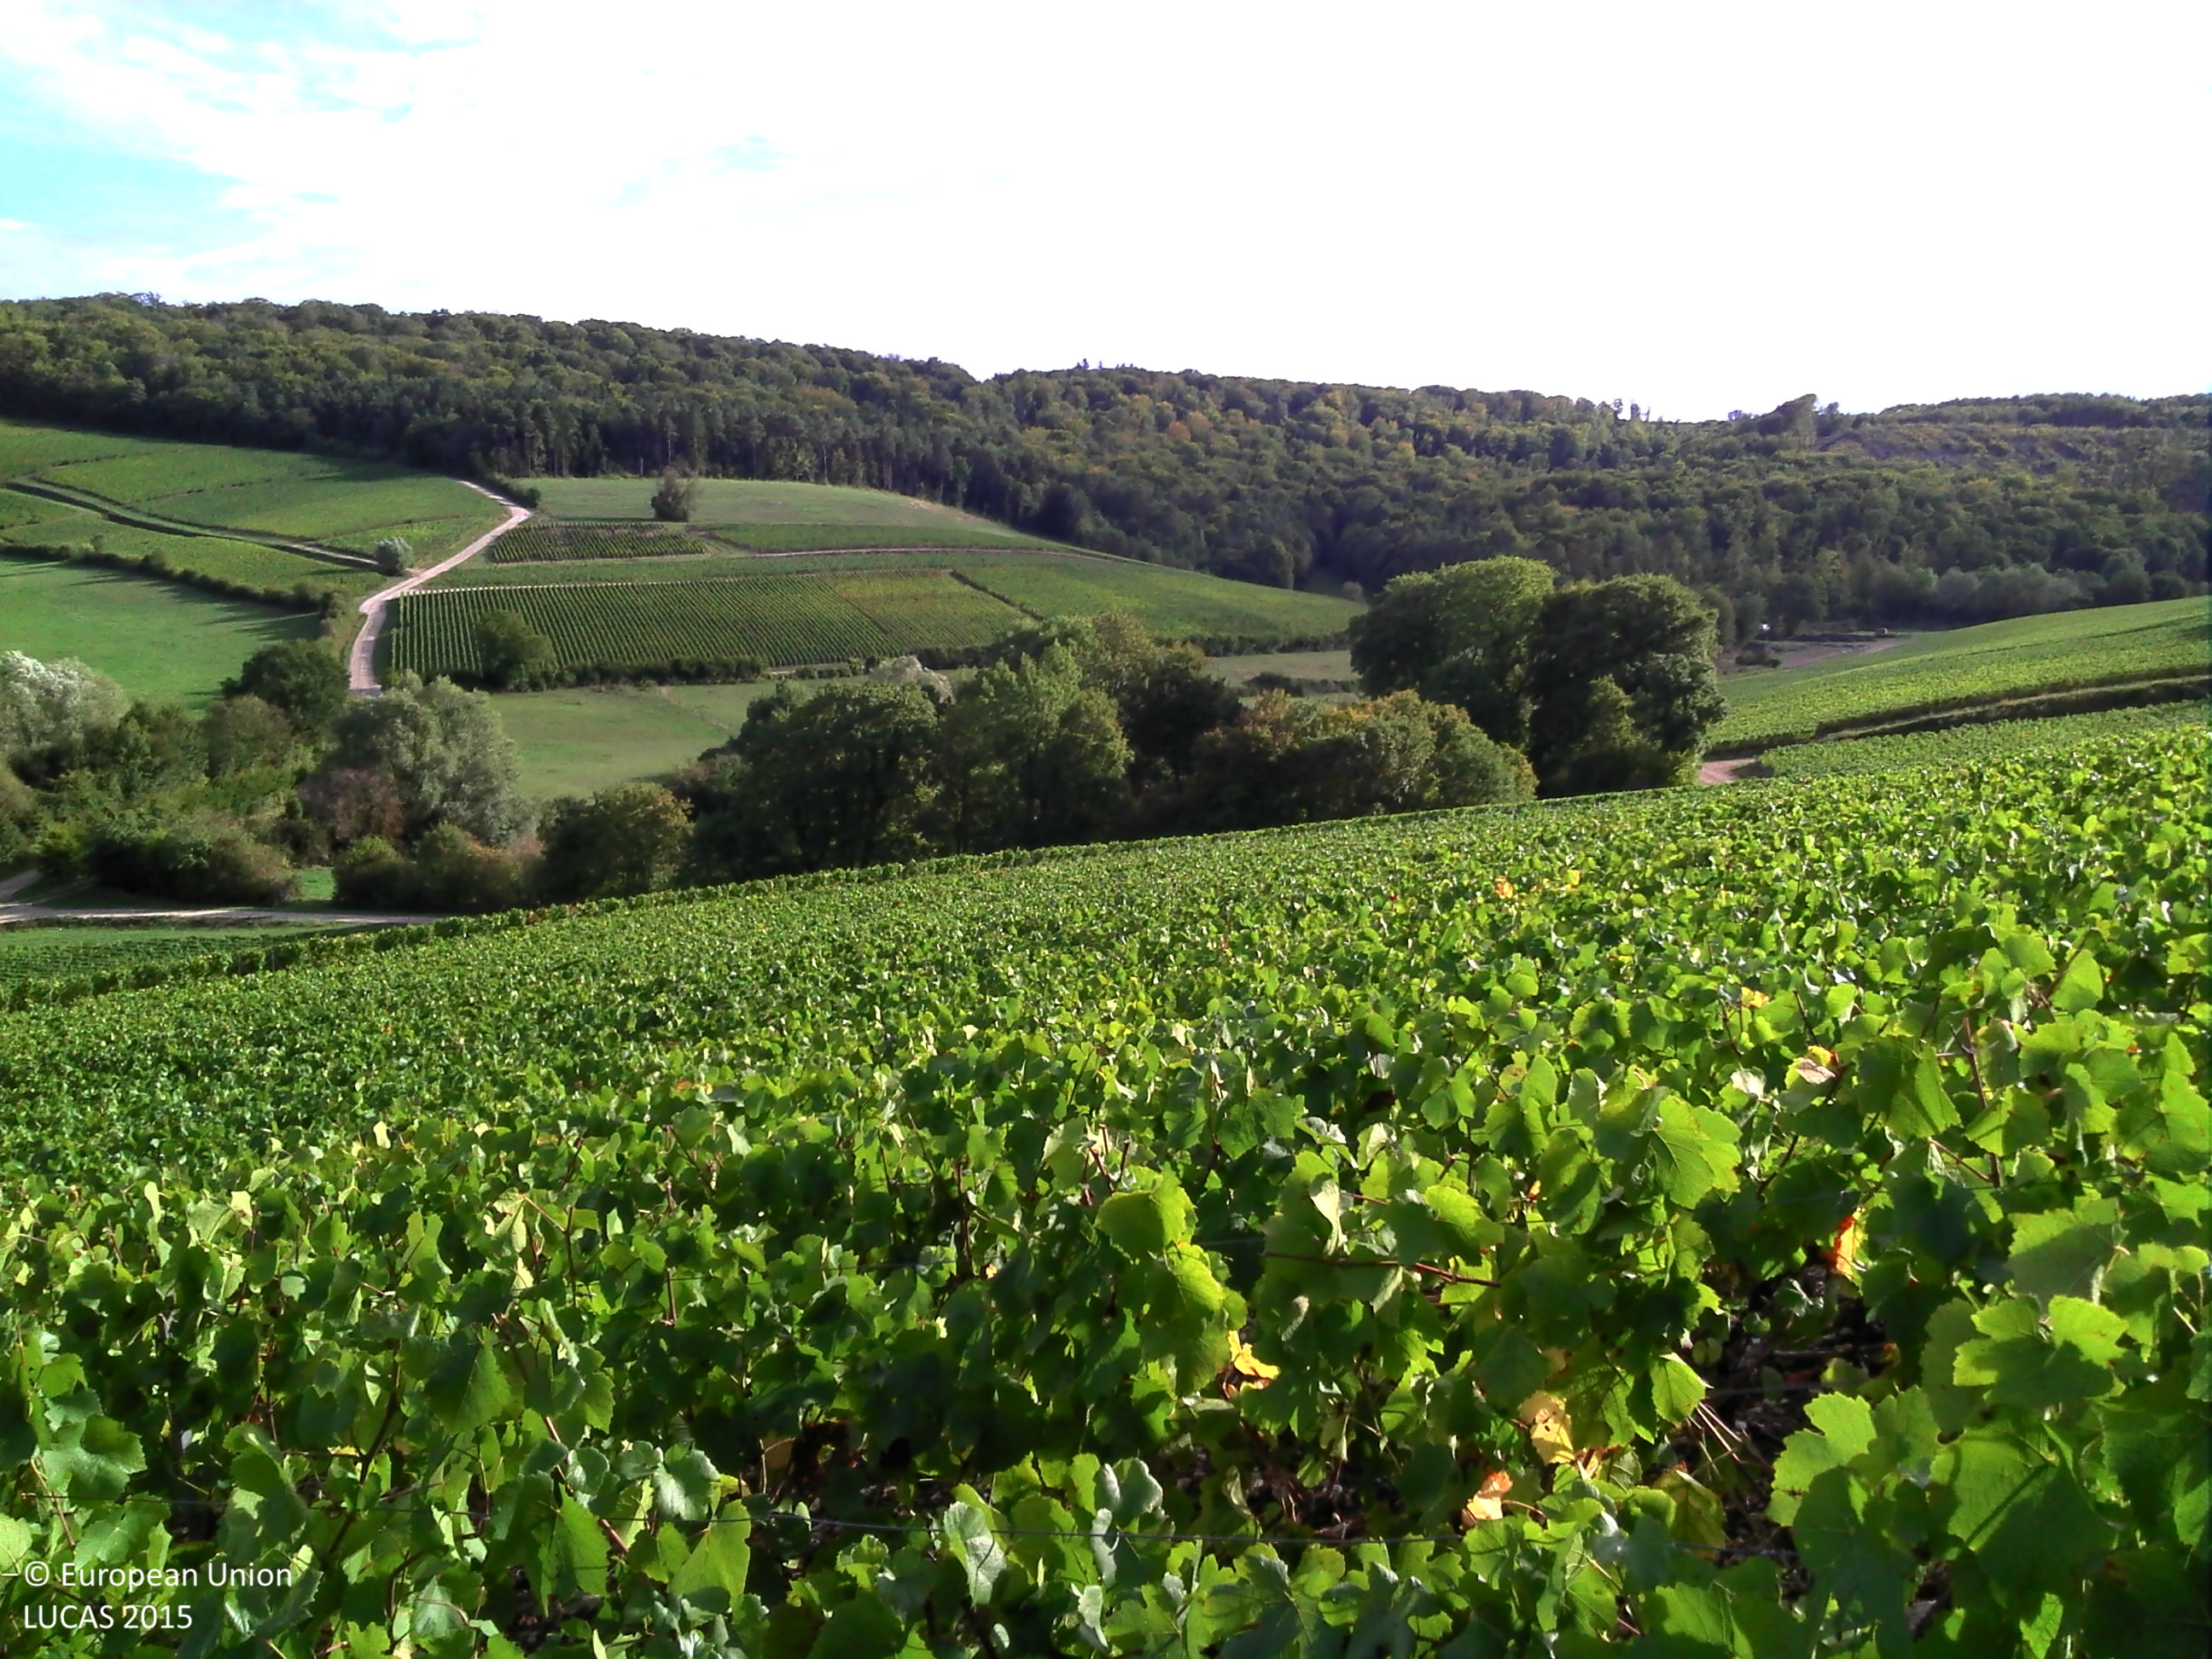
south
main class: Cropland
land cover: Vineyards
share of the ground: 25 - 50 %
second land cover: Other bare soil
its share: > 75 %
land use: Agriculture (excluding fallow land and kitchen gardens)
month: September
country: FR
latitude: 48.1868
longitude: 4.7119
